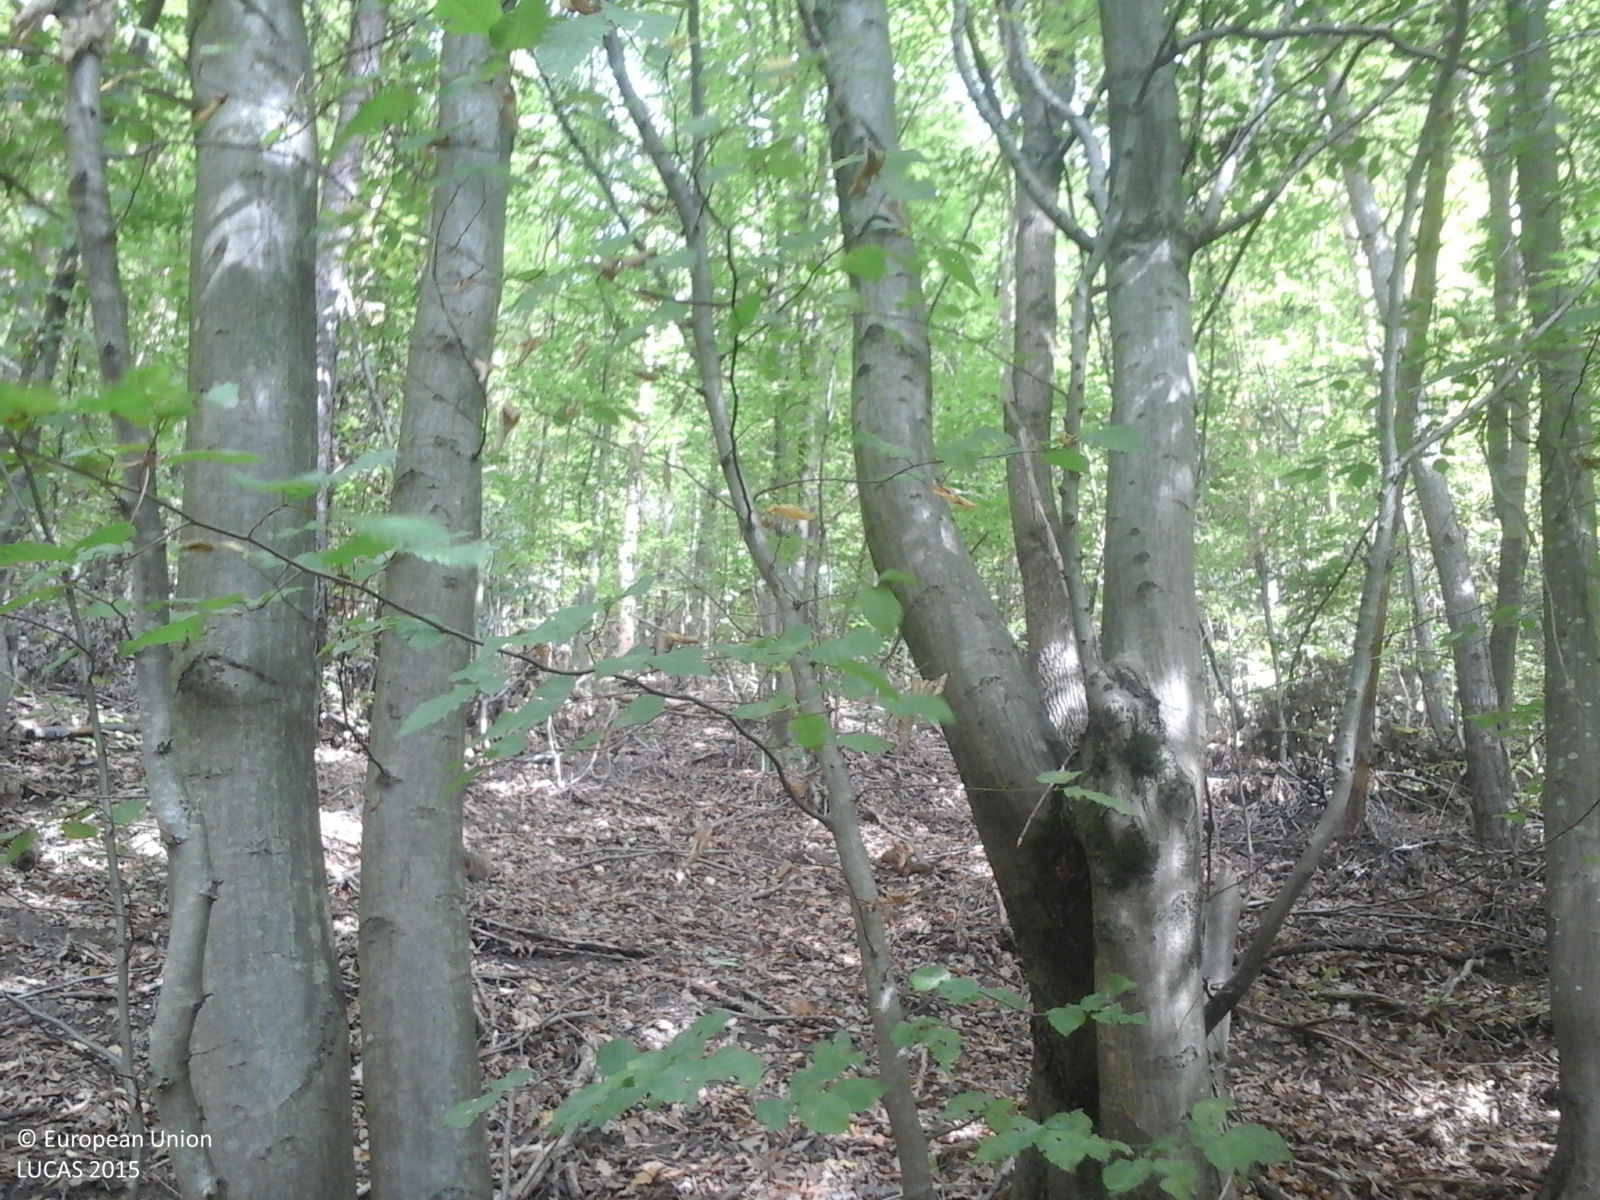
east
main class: Woodland
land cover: Other mixed woodland
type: beech forest
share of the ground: > 75 %
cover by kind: broadleaved forest trees 70 %, coniferous forest trees 30 %
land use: Forestry
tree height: > 5 m
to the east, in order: Other mixed woodland
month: September
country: RO
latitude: 45.9043
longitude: 23.1152
